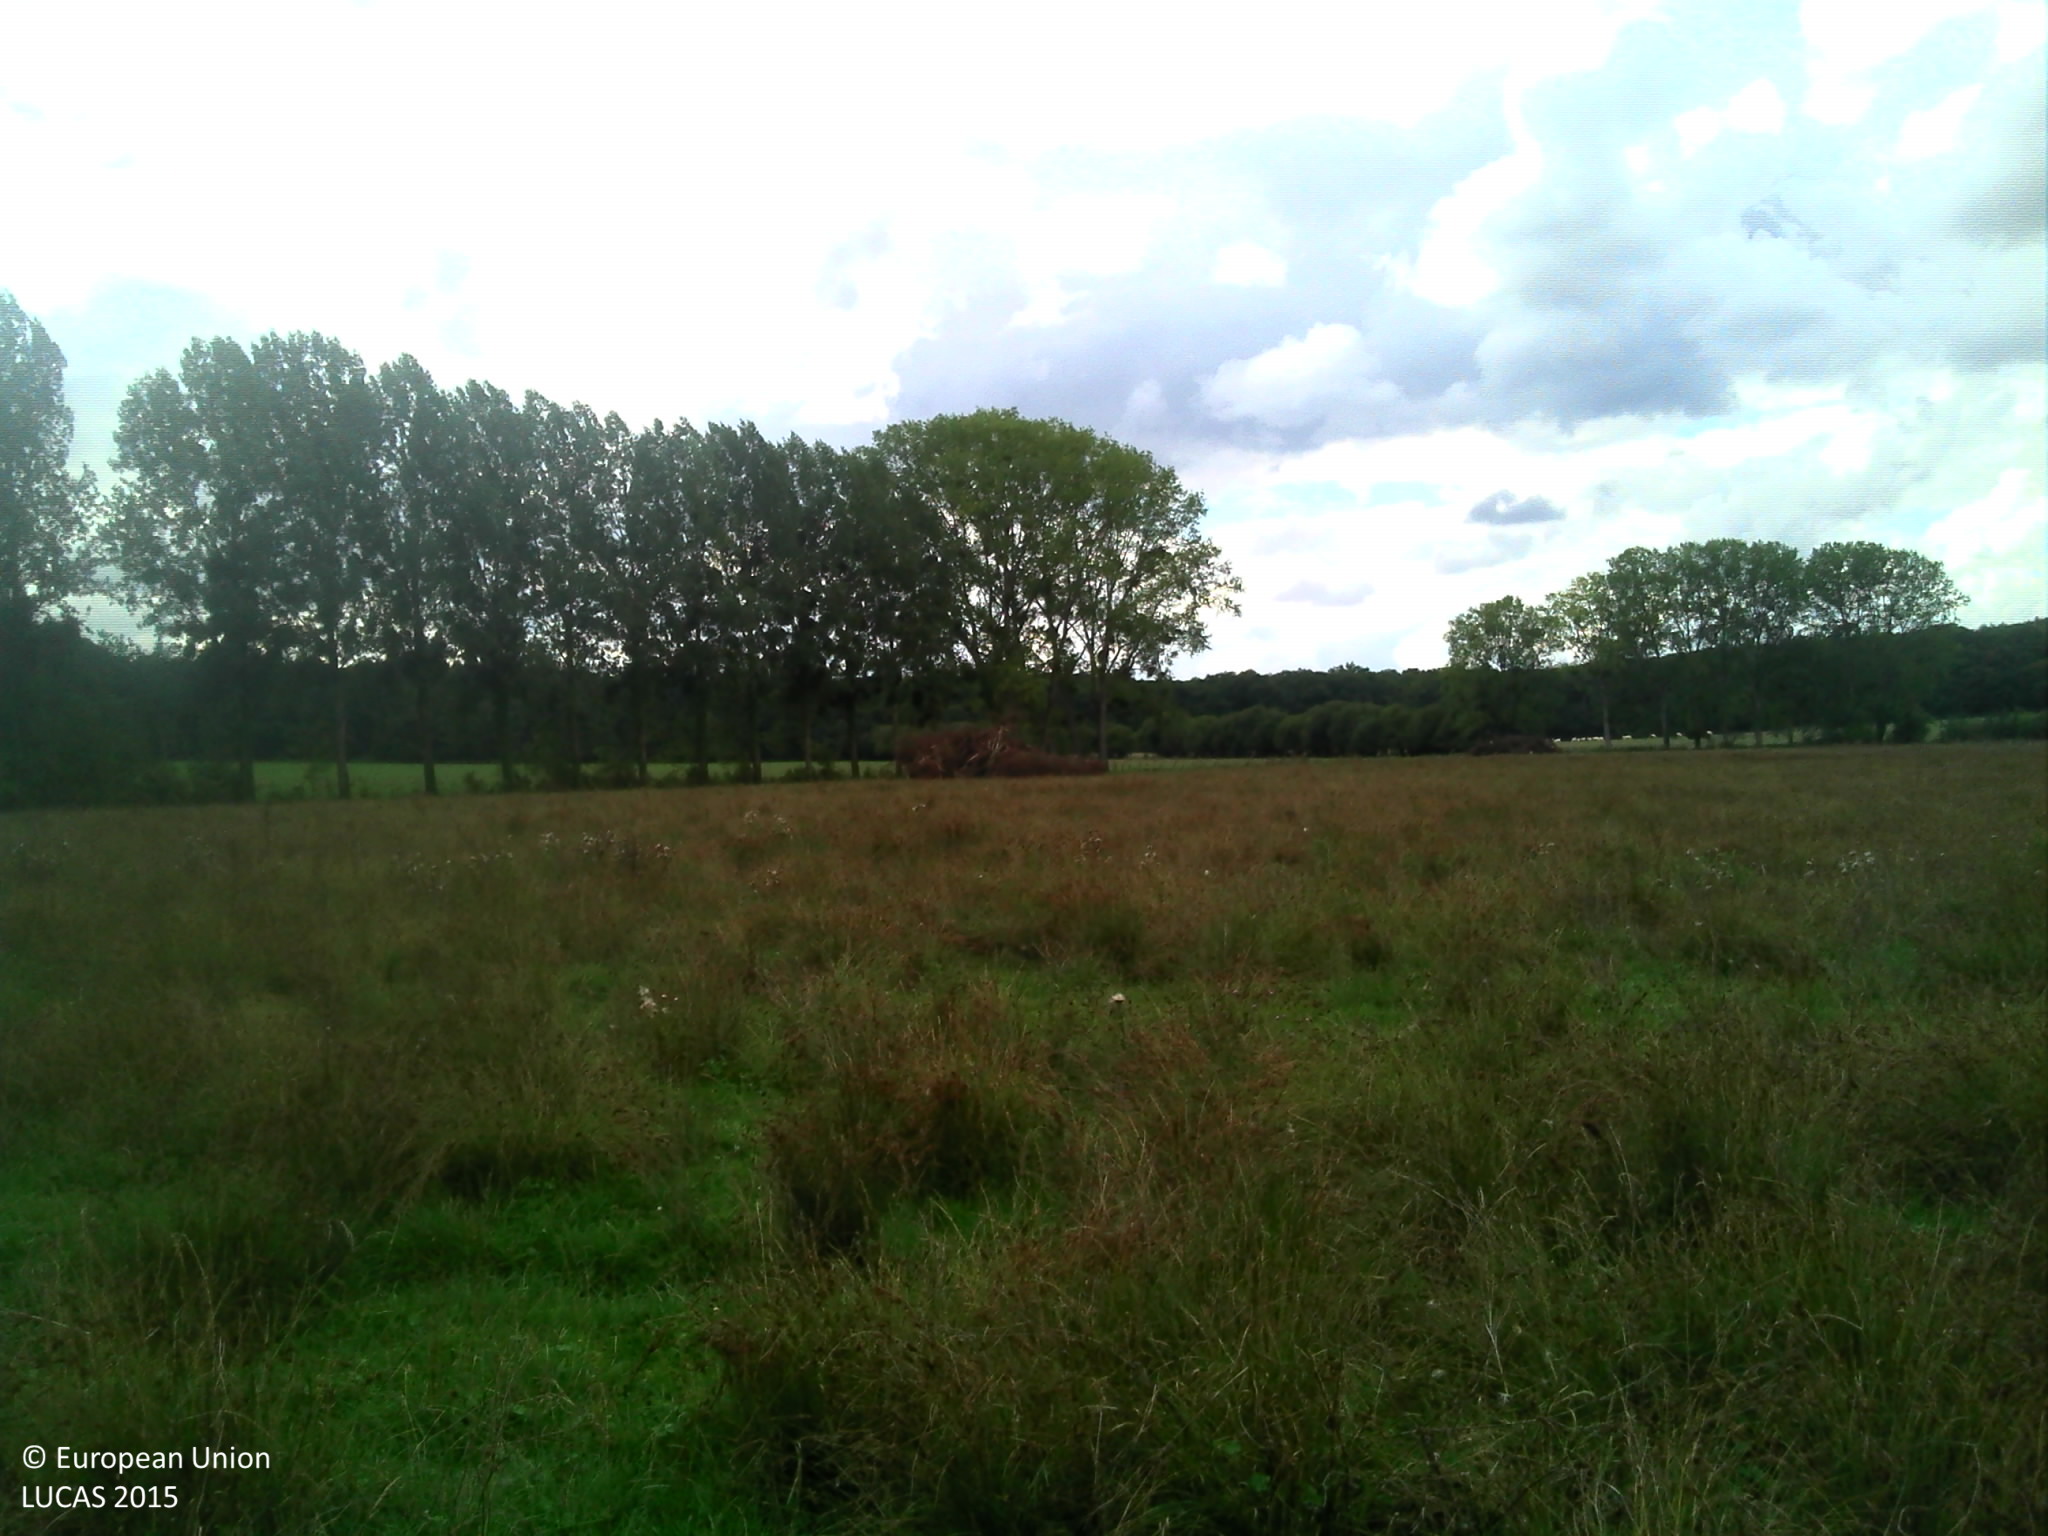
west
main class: Grassland
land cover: Grassland without tree/shrub cover
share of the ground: > 75 %
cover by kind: herbaceous plants 95 %, shrubs 5 %
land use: Agriculture (excluding fallow land and kitchen gardens)
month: September
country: FR
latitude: 48.3038
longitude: 0.5252
